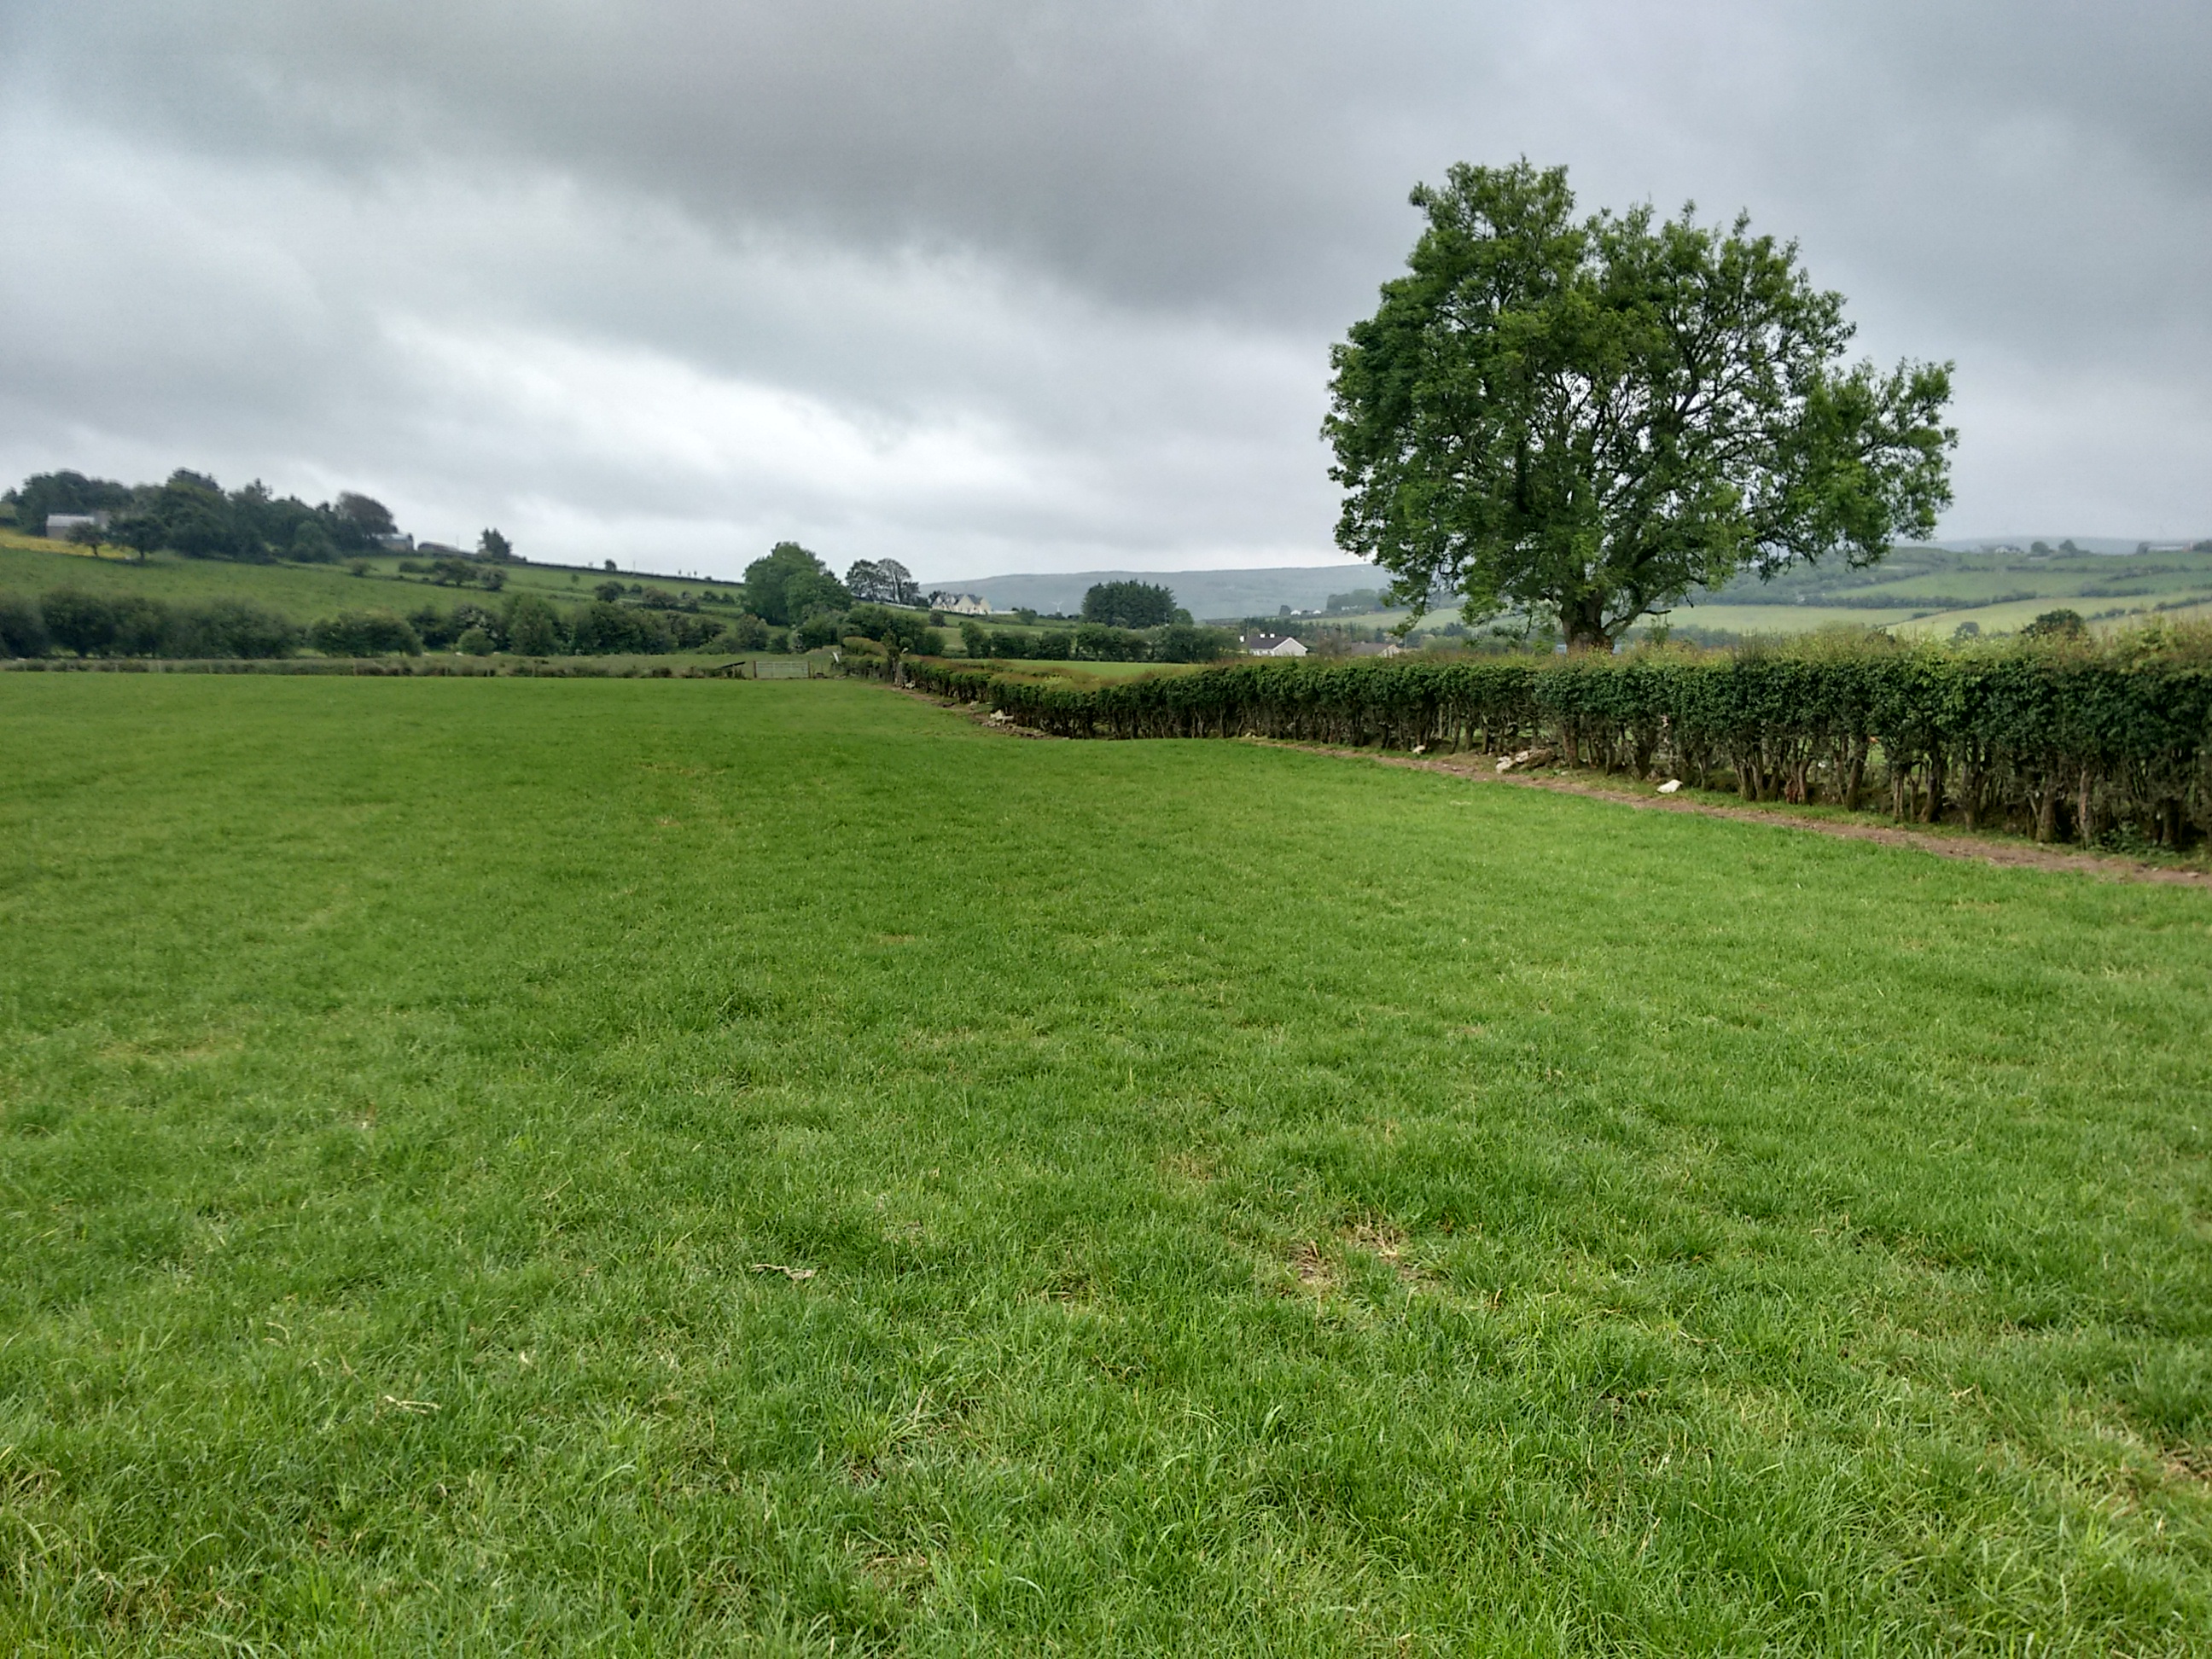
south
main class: Grassland
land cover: Grassland without tree/shrub cover
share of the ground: > 75 %
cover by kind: herbaceous plants 100 %
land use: Agriculture (excluding fallow land and kitchen gardens)
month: June
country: GB
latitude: 54.6783
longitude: -7.6065
